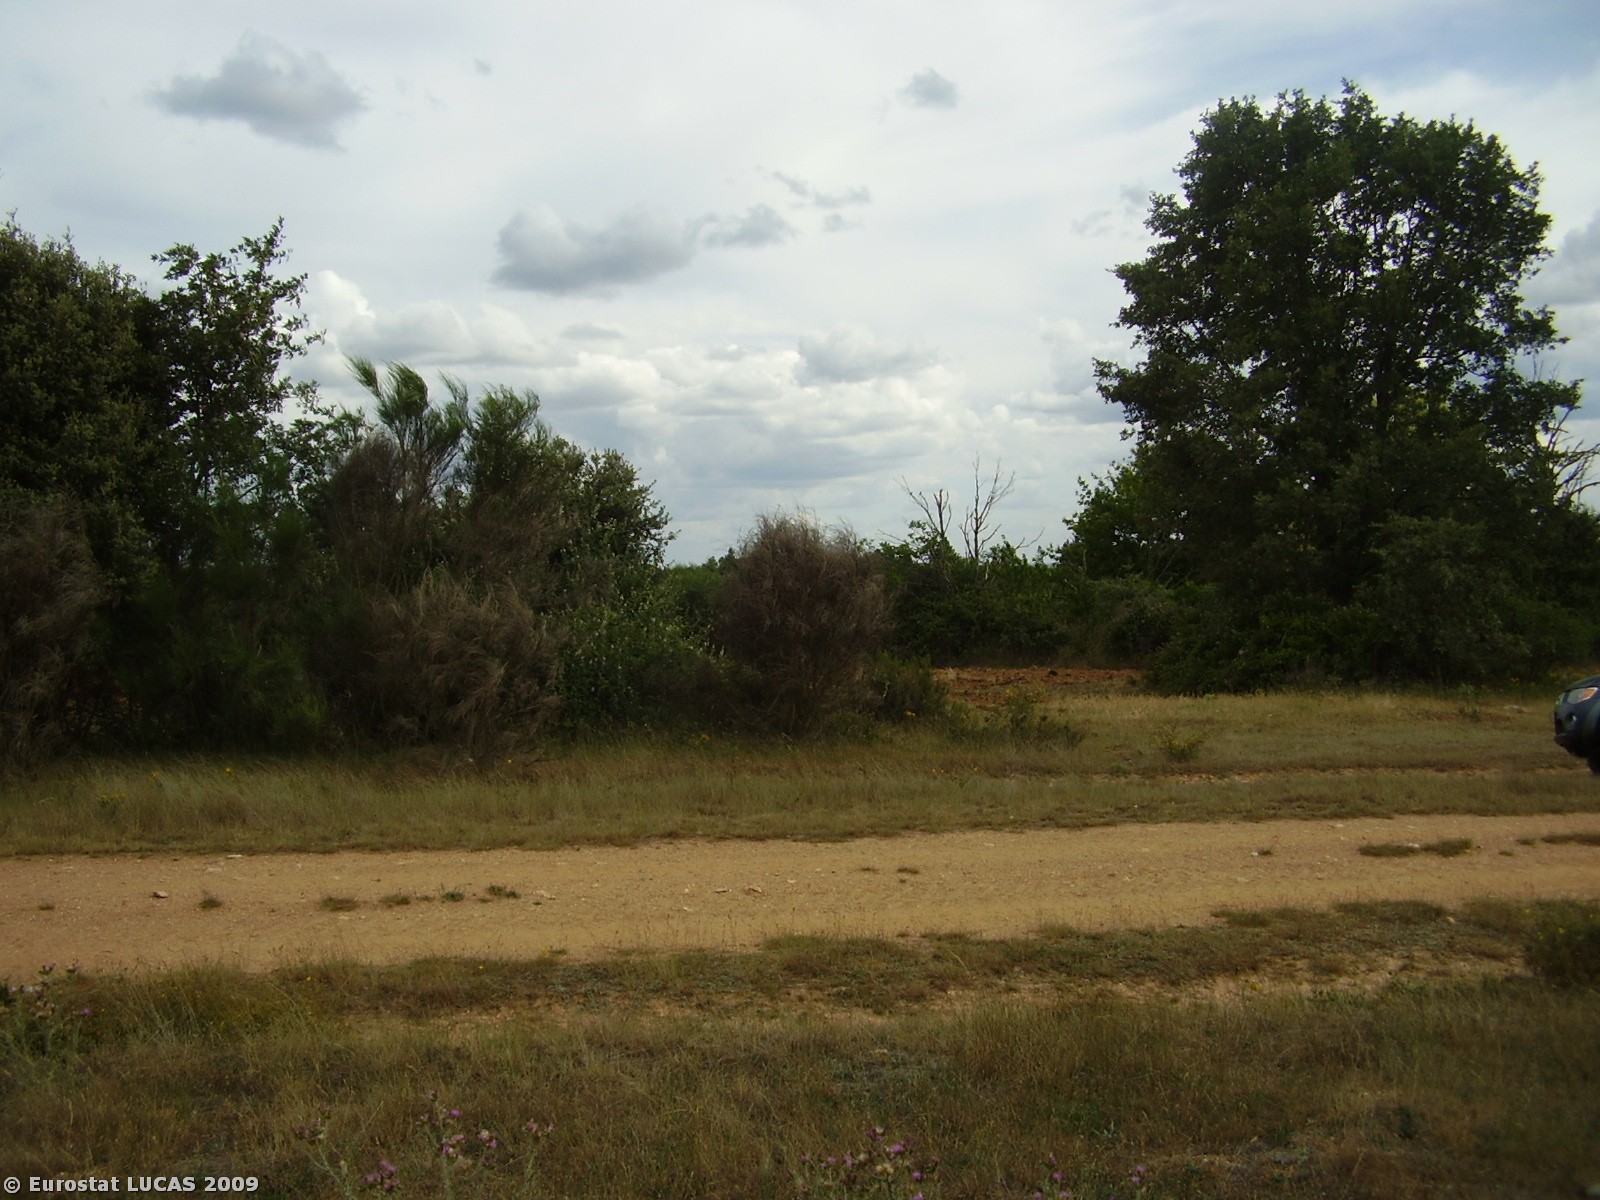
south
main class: Grassland
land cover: Spontaneously vegetated surfaces
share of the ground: > 75 %
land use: Unused
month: June
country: PT
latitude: 41.6230
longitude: -6.2662
